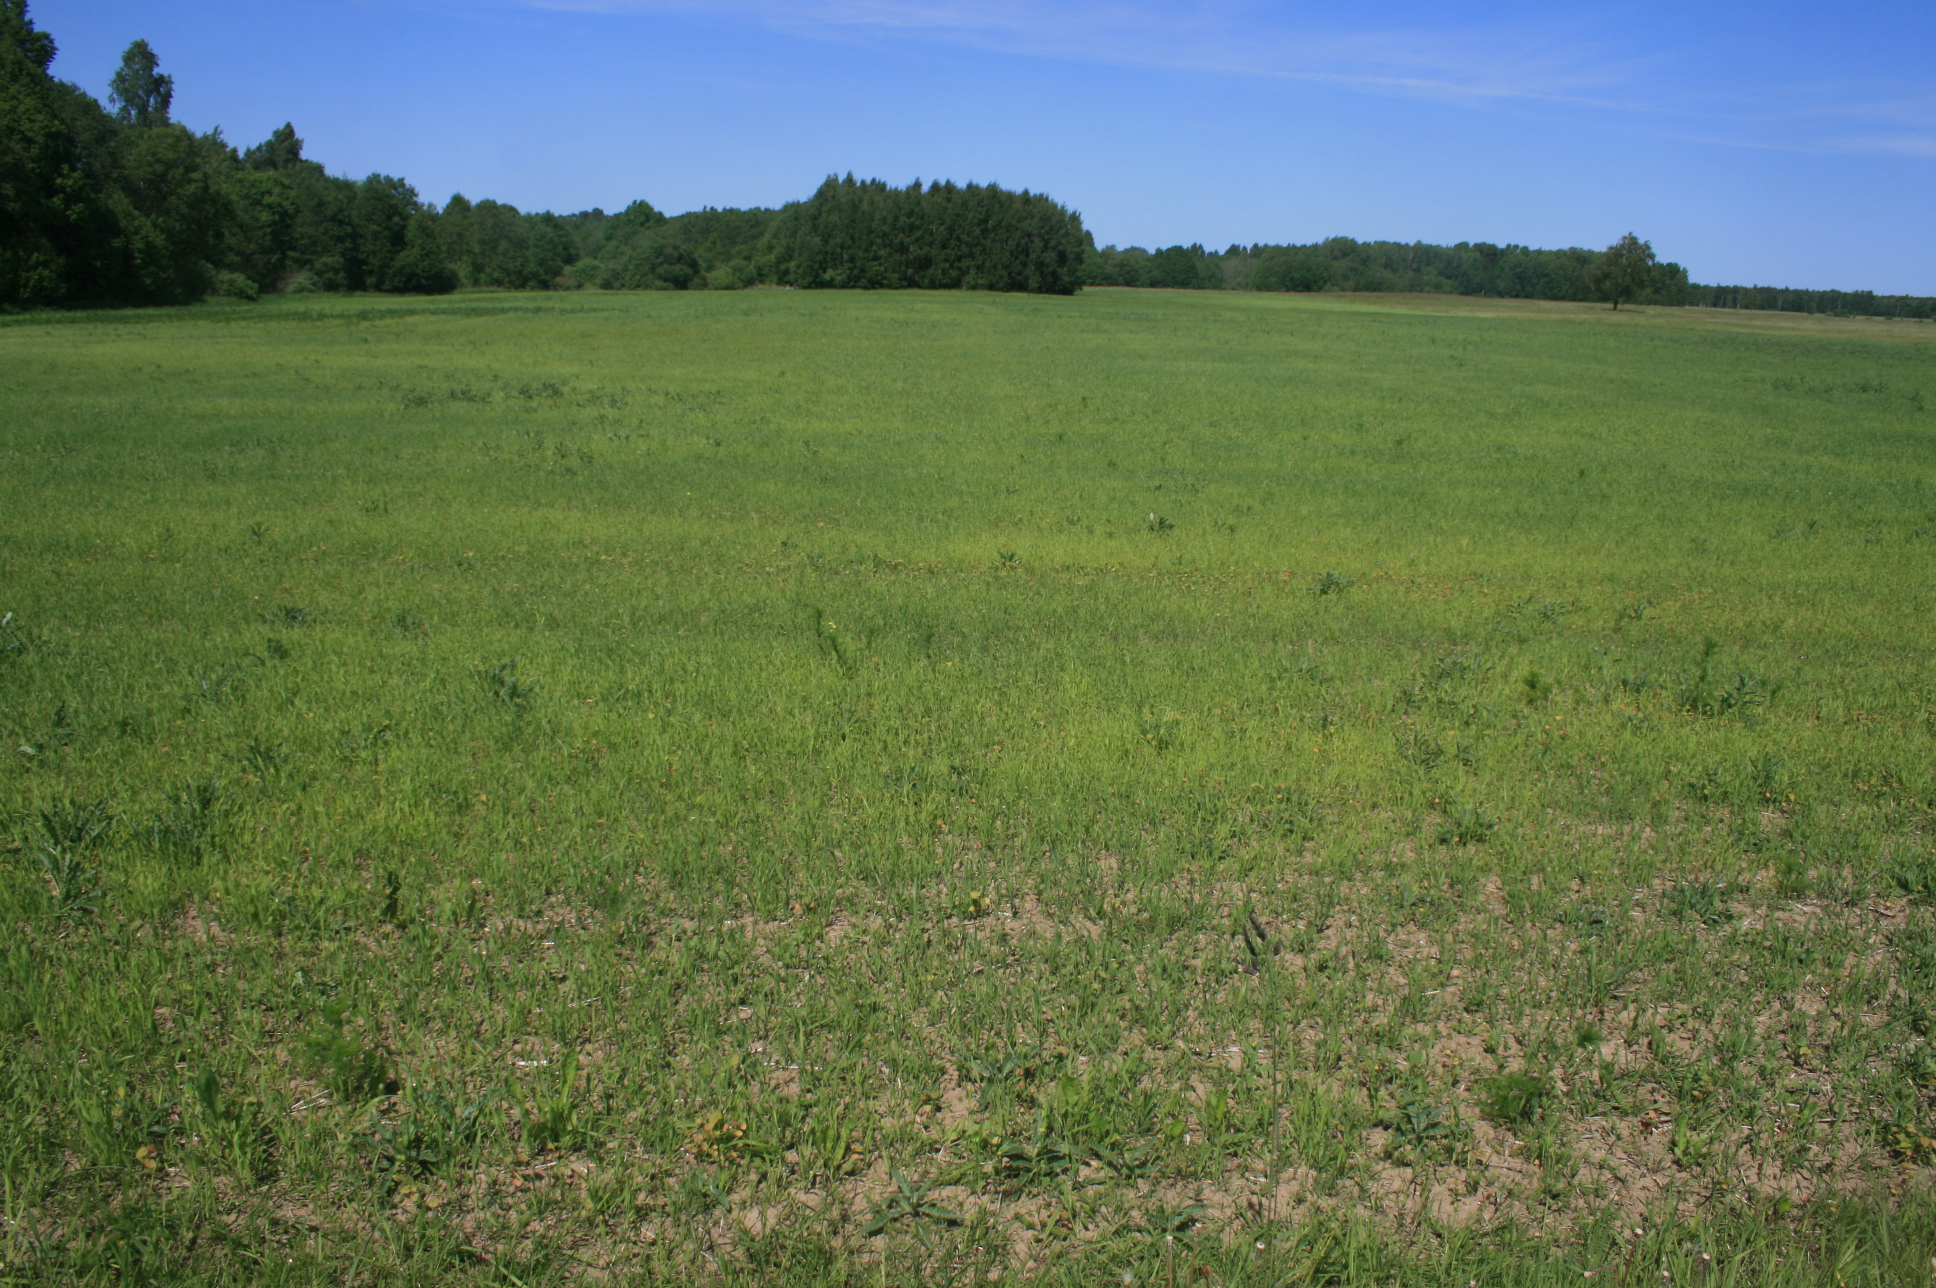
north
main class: Grassland
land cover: Grassland without tree/shrub cover
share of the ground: > 75 %
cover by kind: herbaceous plants 100 %
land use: Agriculture (excluding fallow land and kitchen gardens)
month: June
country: LT
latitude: 55.9297
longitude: 22.3982
